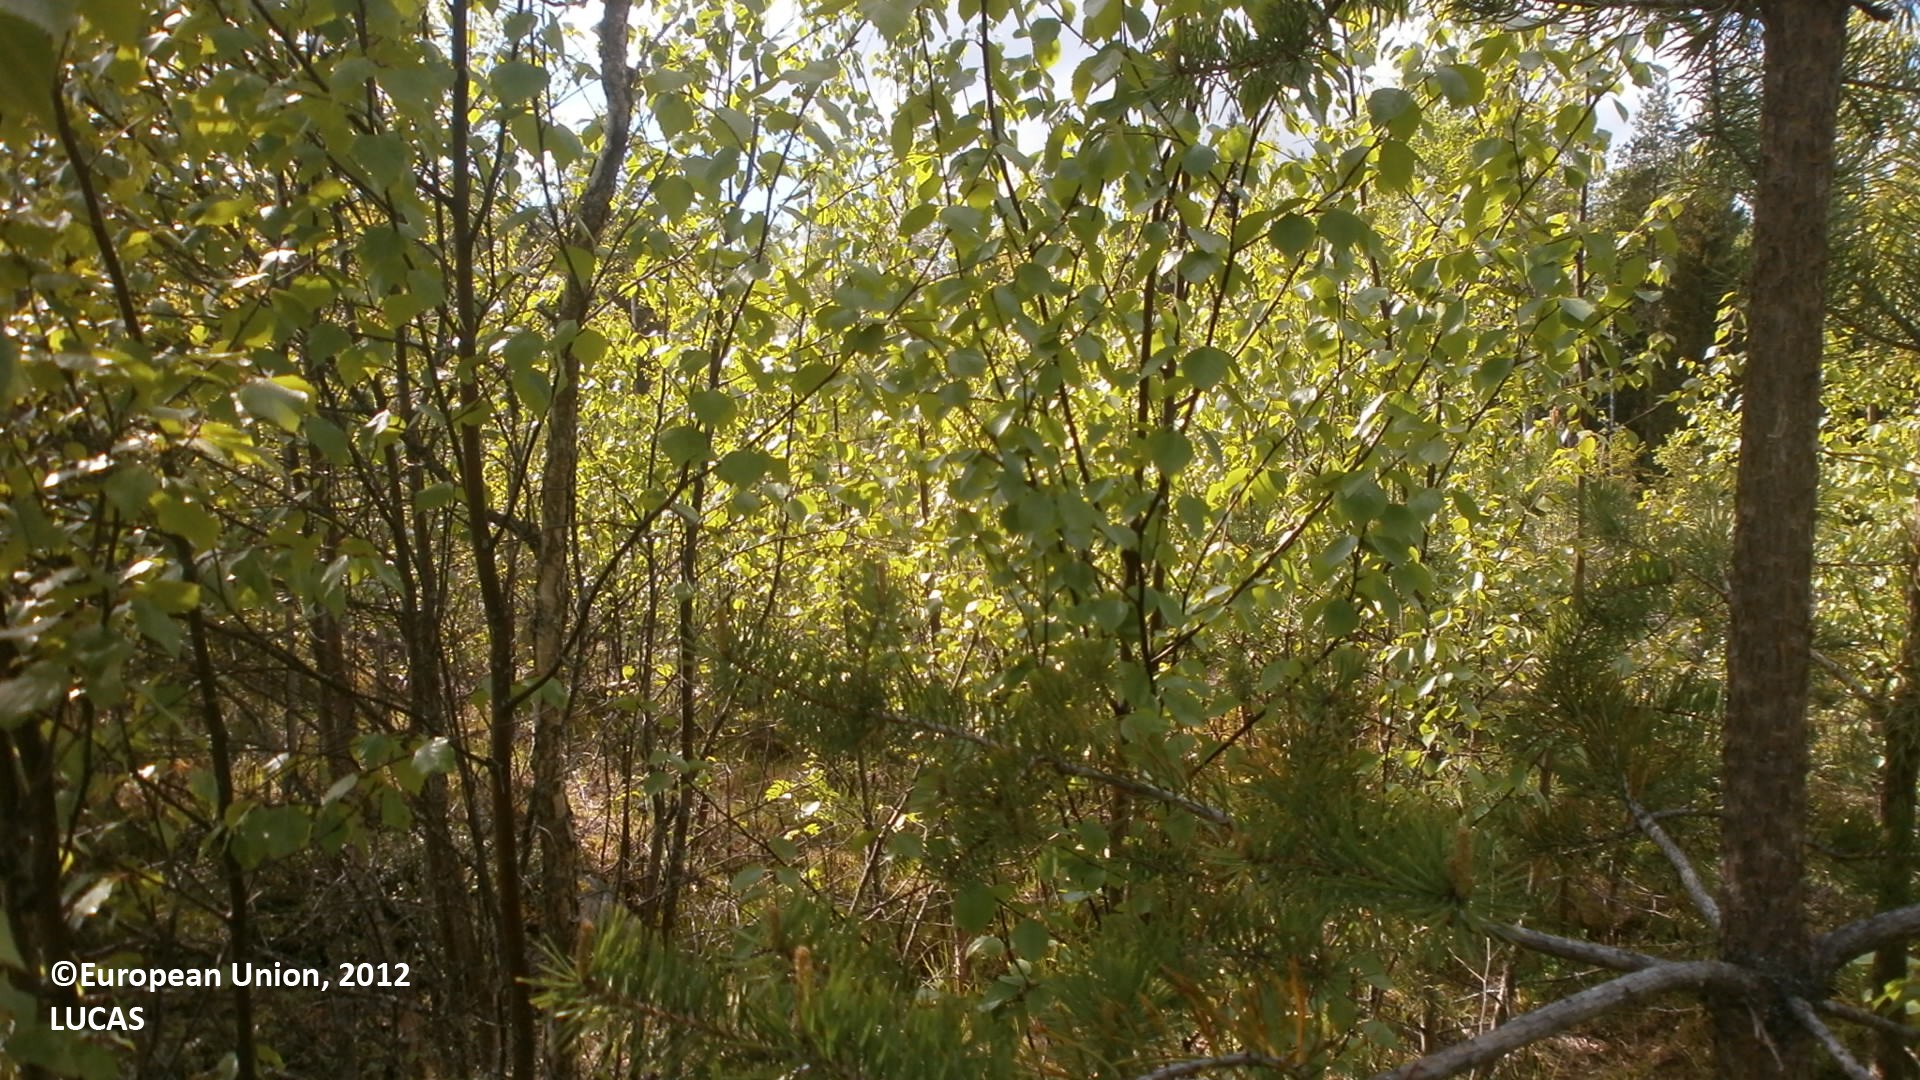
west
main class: Woodland
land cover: Other mixed woodland
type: mire and swamp forests
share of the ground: > 75 %
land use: Forestry
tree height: < 5 m
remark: Clear cut
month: June
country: FI
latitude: 64.5112
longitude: 25.1824
